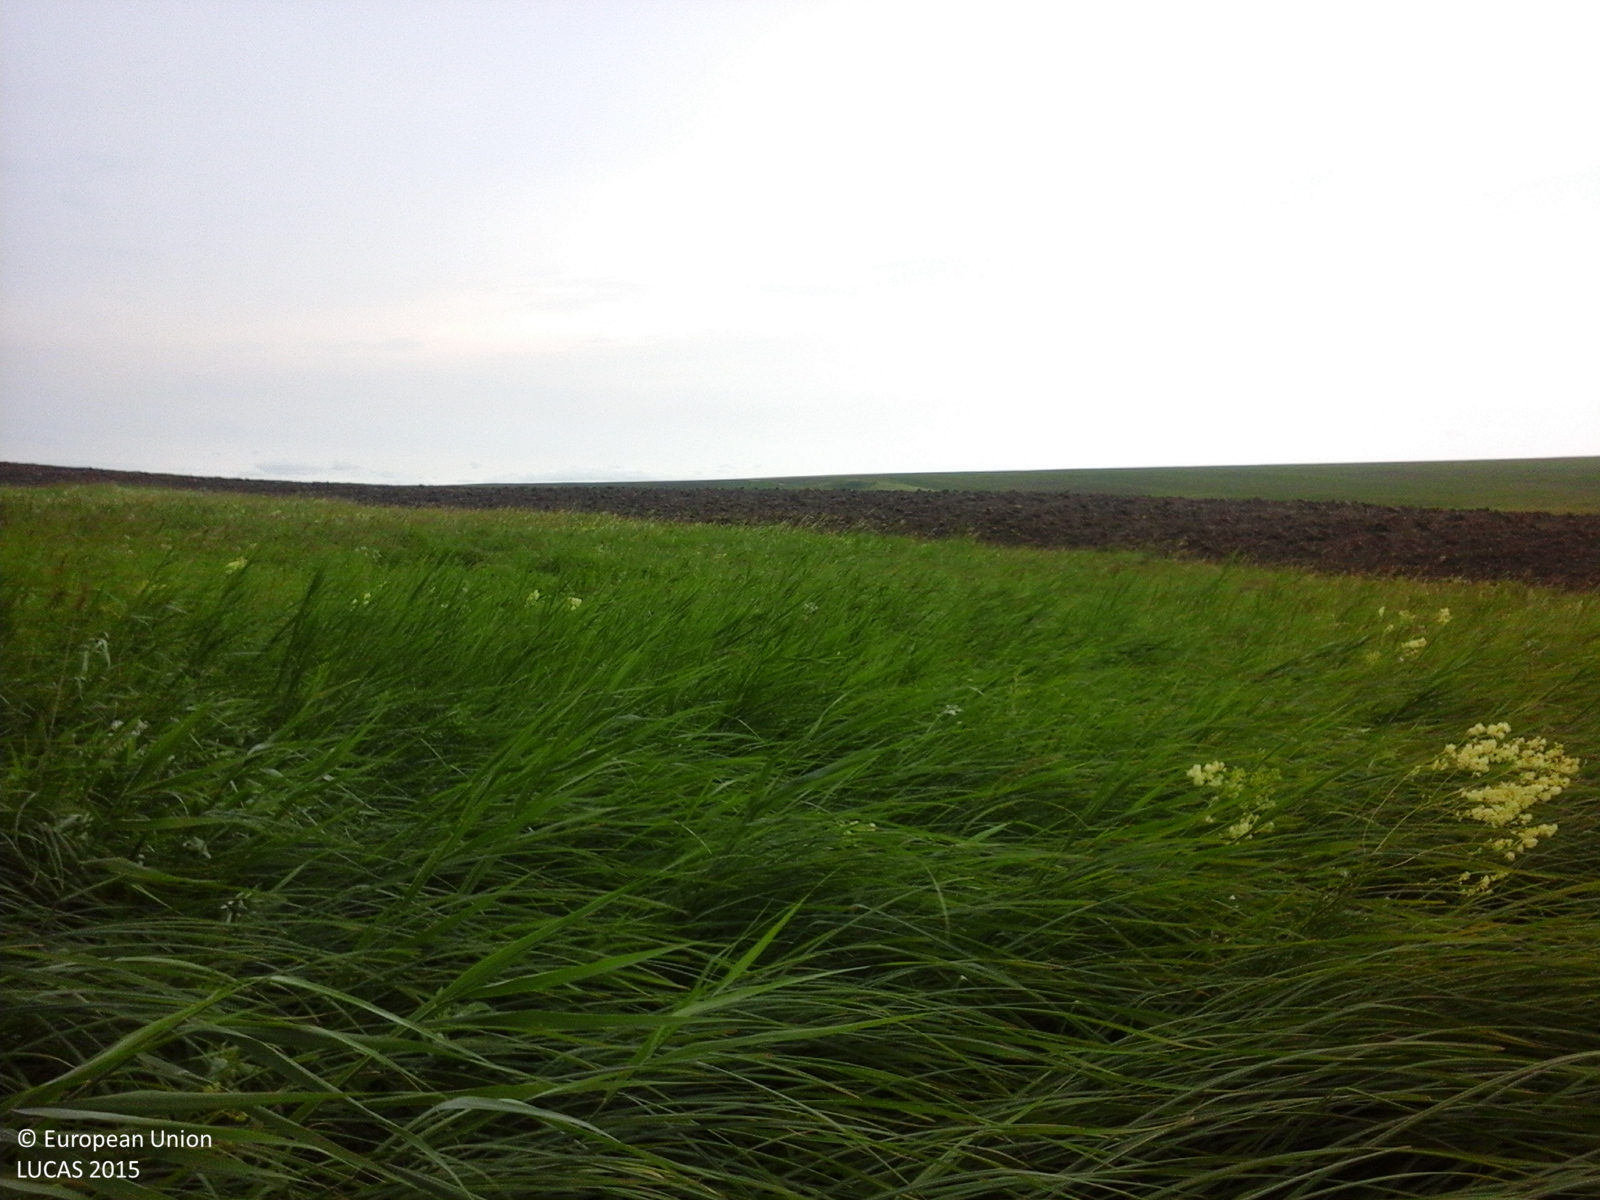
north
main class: Grassland
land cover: Grassland without tree/shrub cover
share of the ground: > 75 %
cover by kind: herbaceous plants 100 %
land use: Agriculture (excluding fallow land and kitchen gardens)
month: June
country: RO
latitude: 47.8923
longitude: 26.5850
